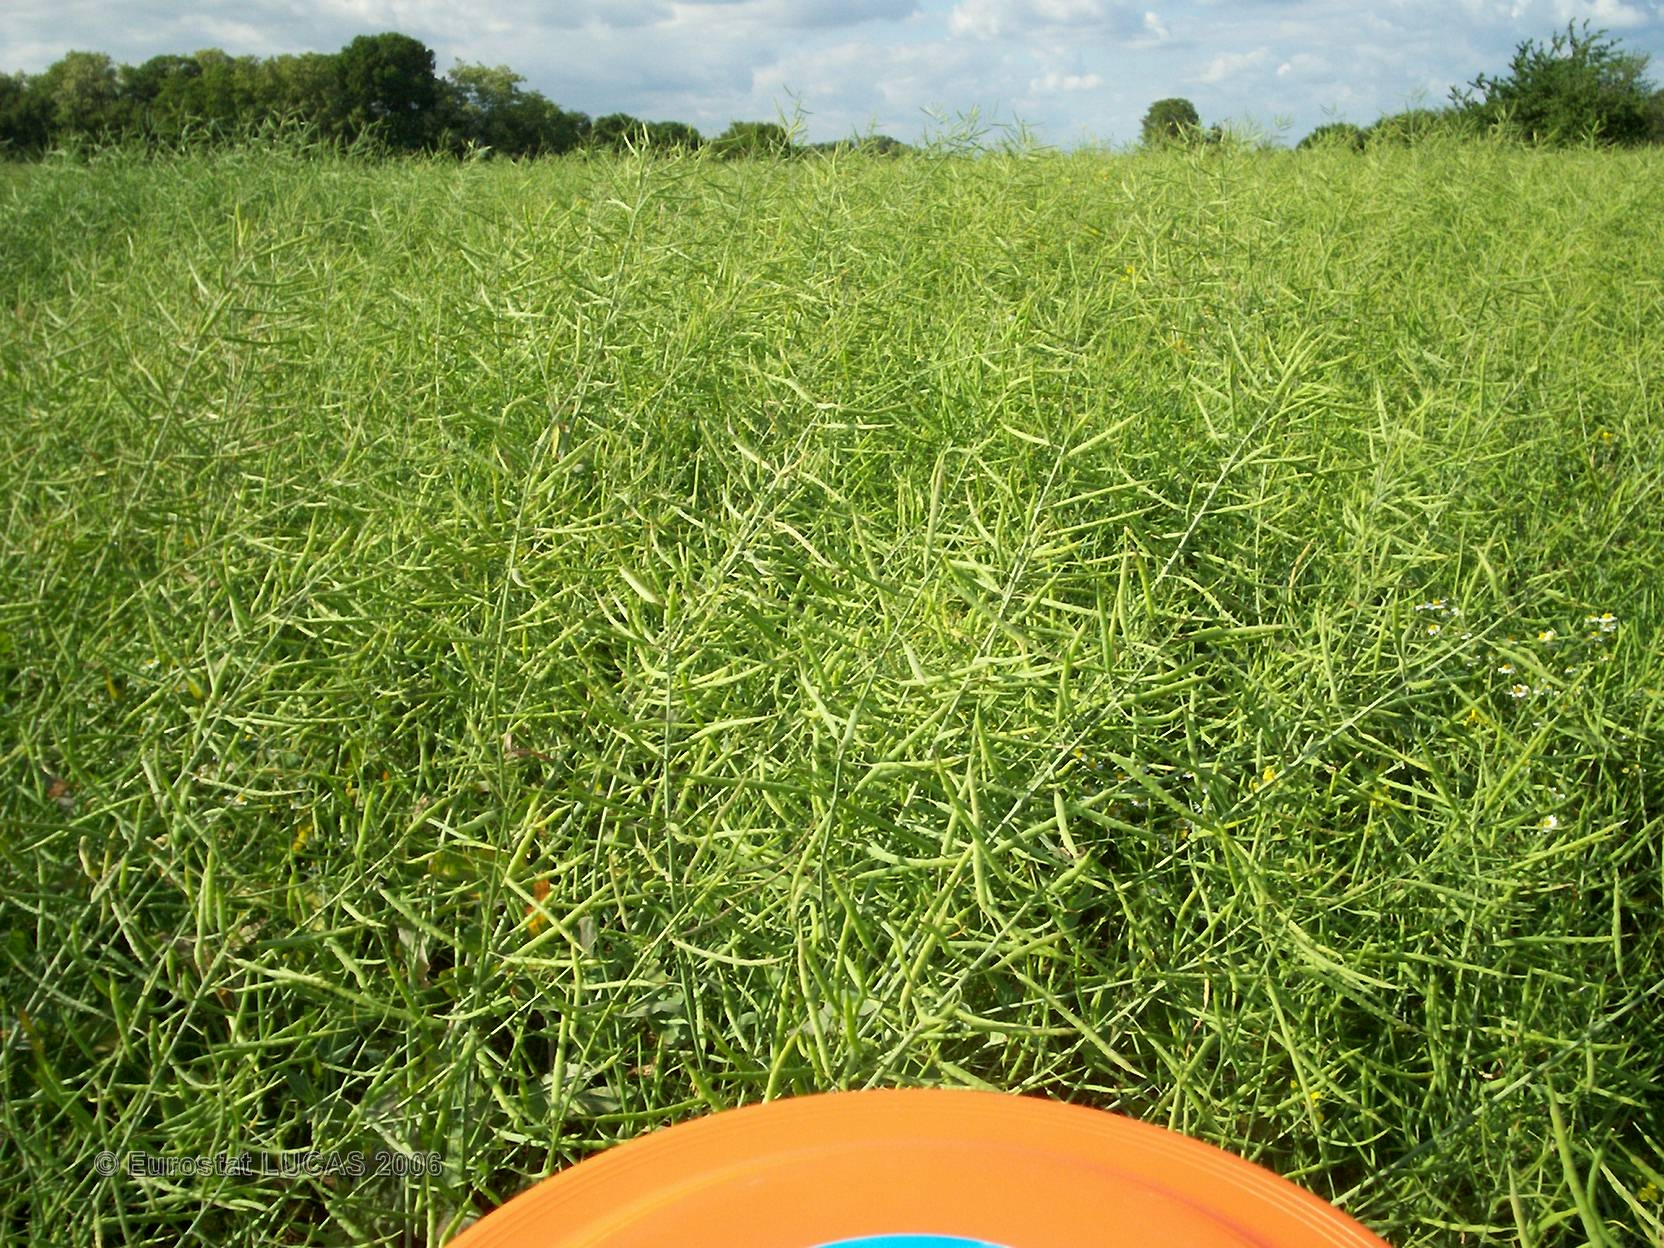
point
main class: Cropland
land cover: Rape and turnip rape
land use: Agriculture (excluding fallow land and kitchen gardens)
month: June
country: FR
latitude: 47.1156
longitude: 2.9970
